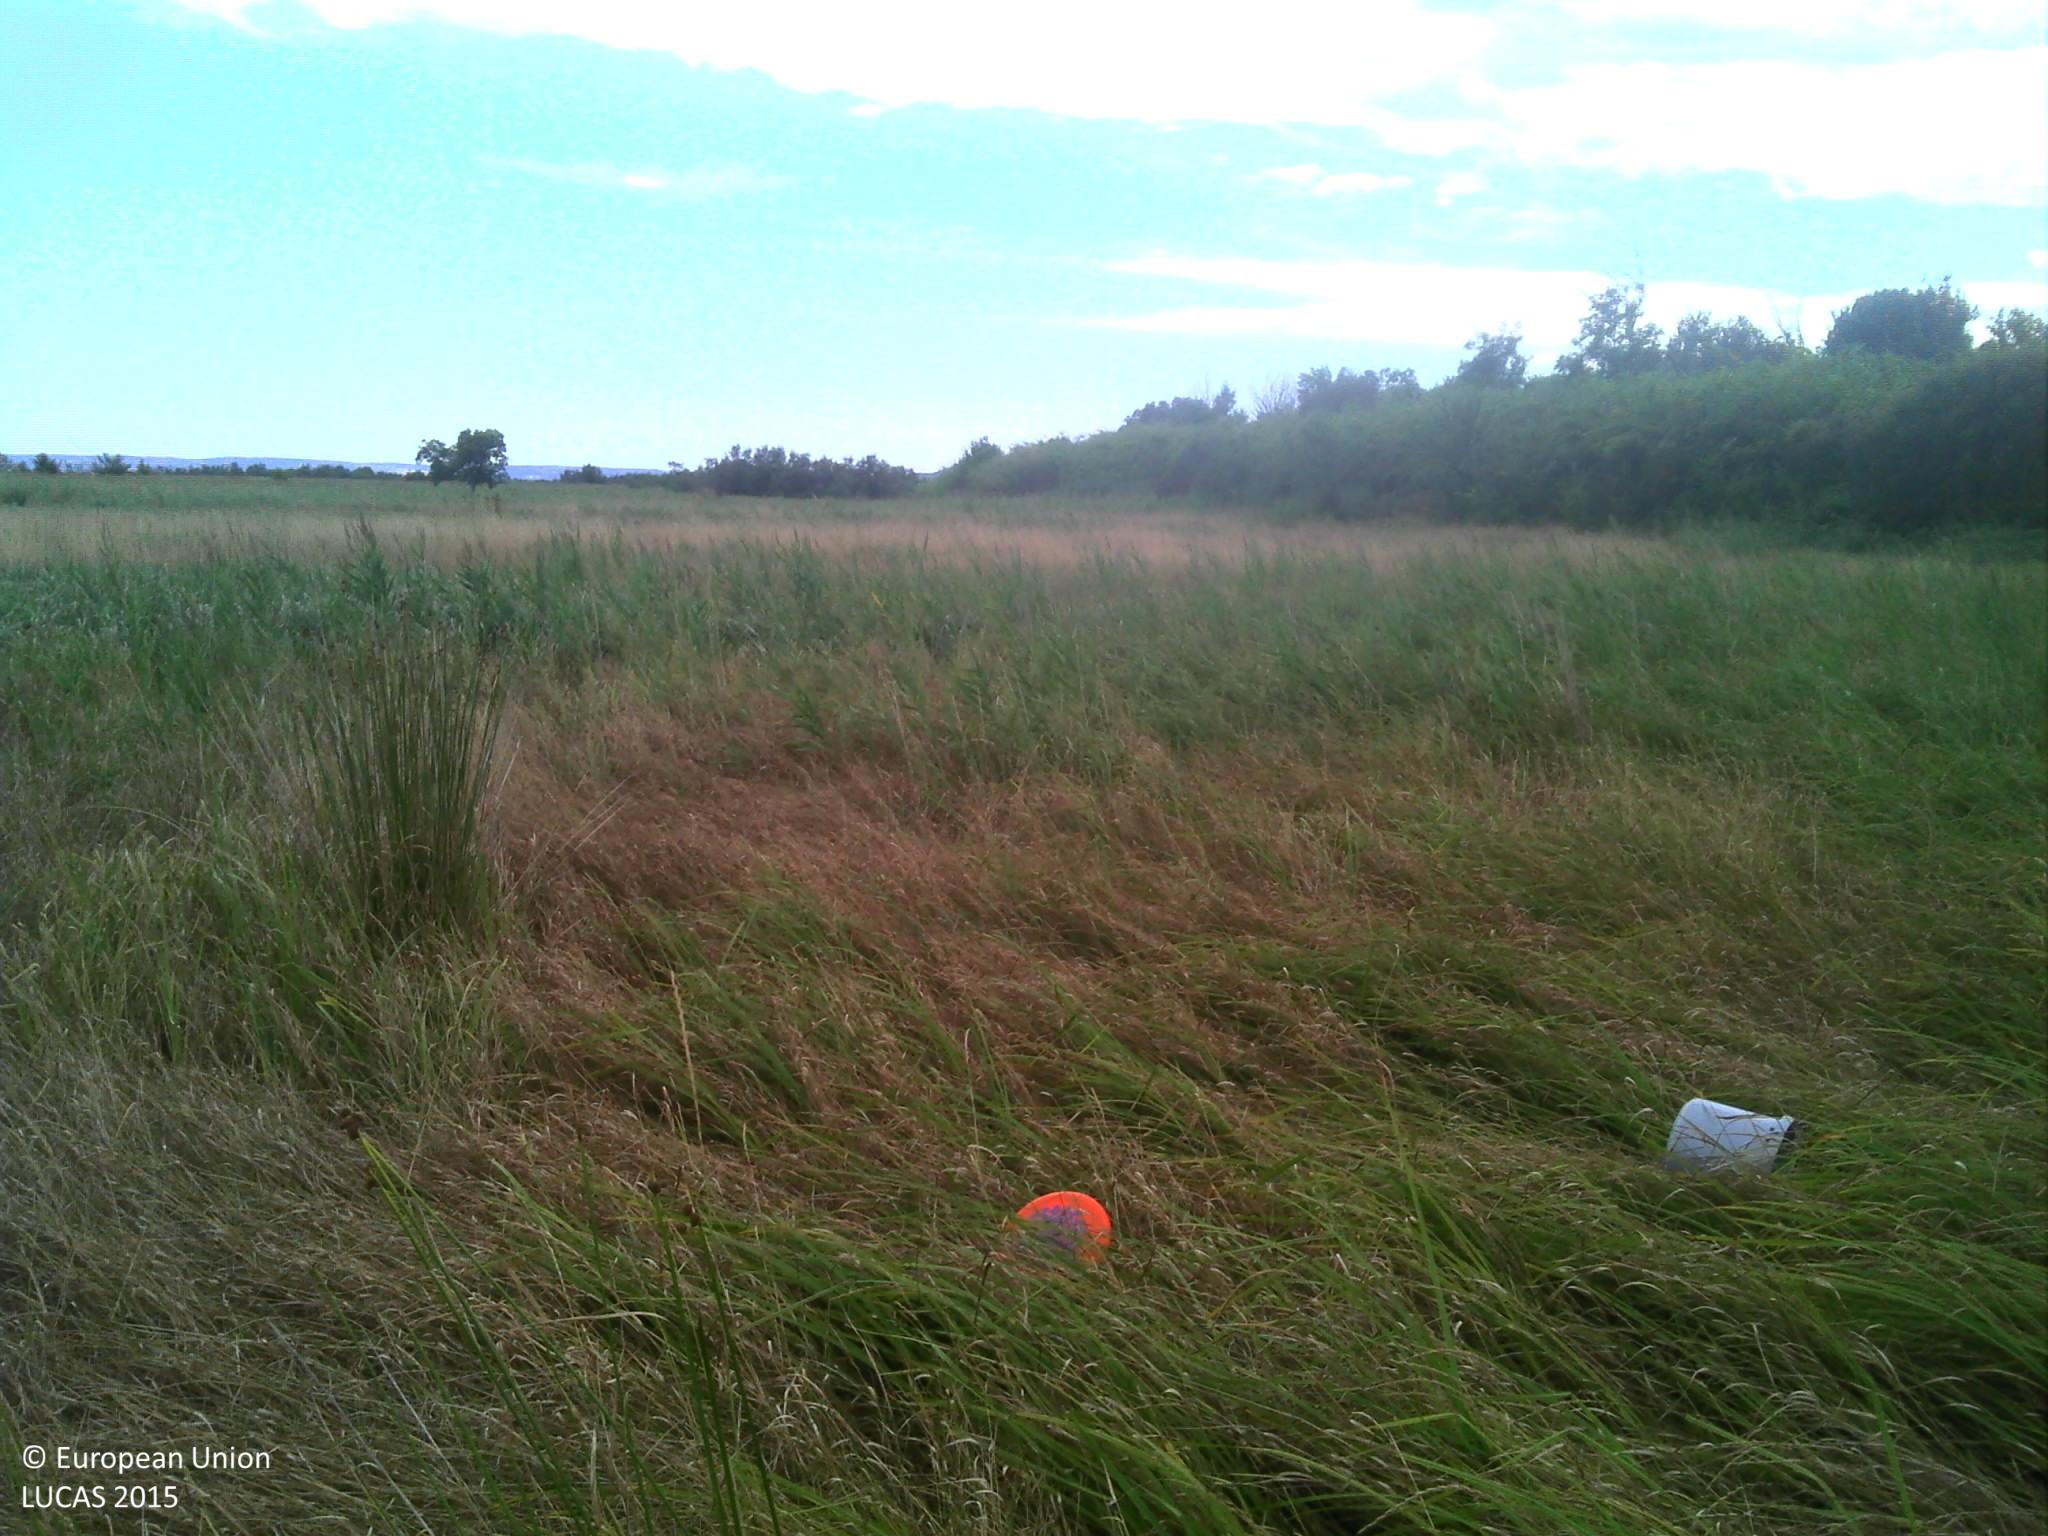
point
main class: Grassland
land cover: Grassland without tree/shrub cover
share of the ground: > 75 %
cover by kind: herbaceous plants 95 %, shrubs 5 %
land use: Semi-natural and natural areas not in use
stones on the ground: < 10 %
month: July
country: FR
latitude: 43.5275
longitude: 5.0483
